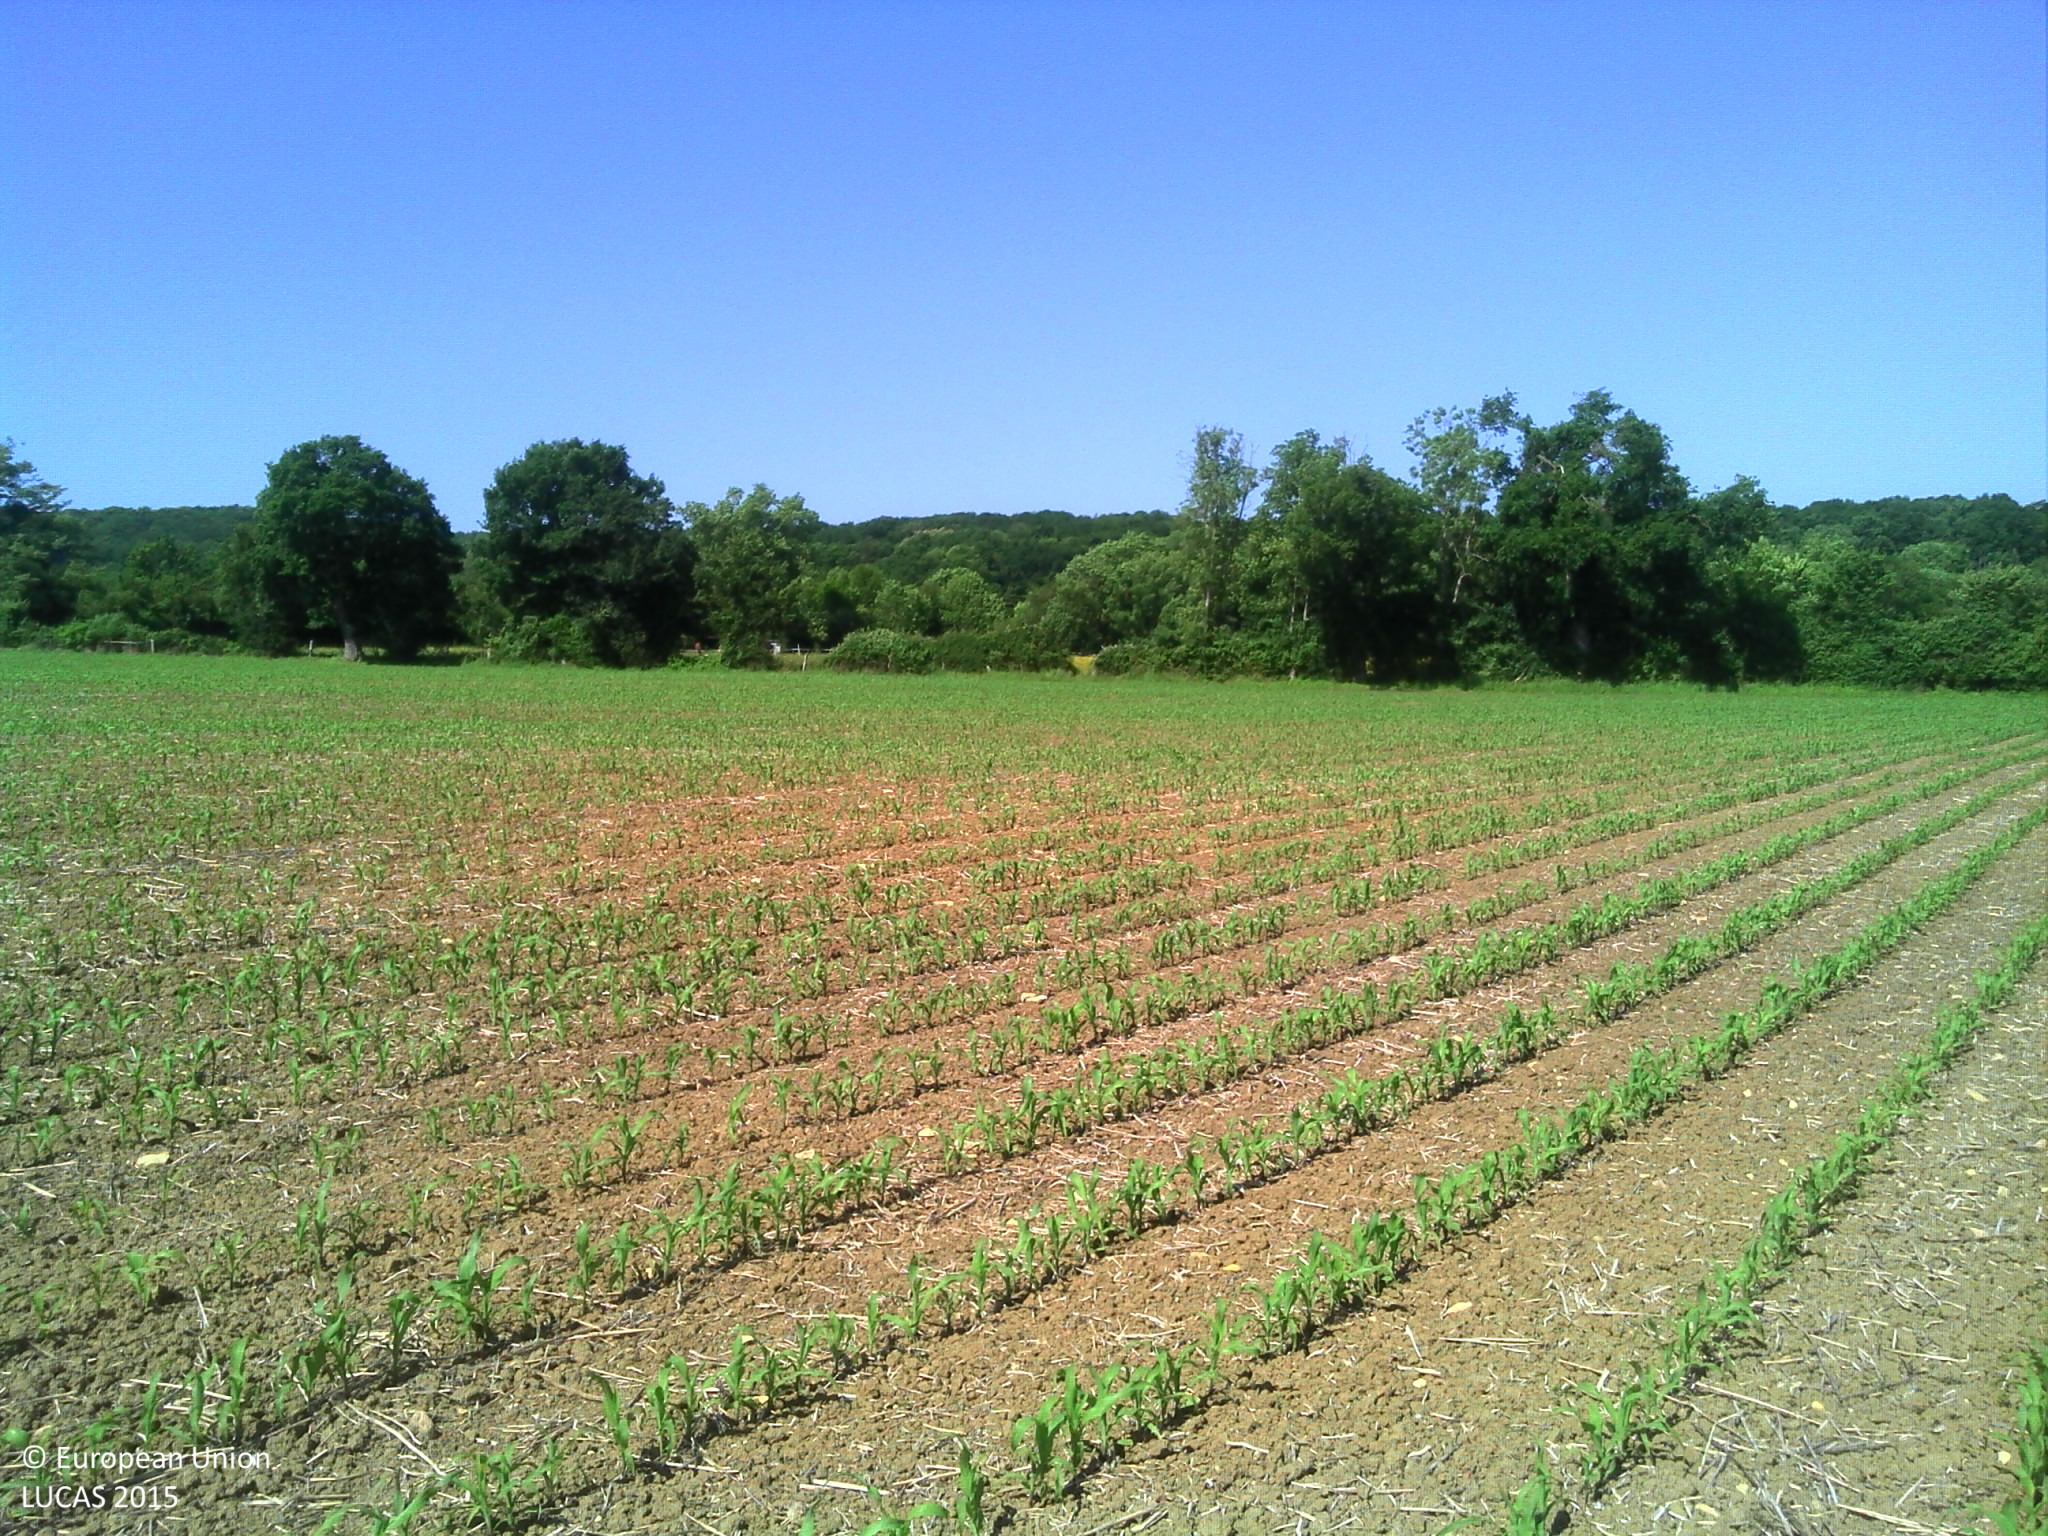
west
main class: Cropland
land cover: Maize
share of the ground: < 10 %
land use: Agriculture (excluding fallow land and kitchen gardens)
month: June
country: FR
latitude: 48.7743
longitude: 0.1055
